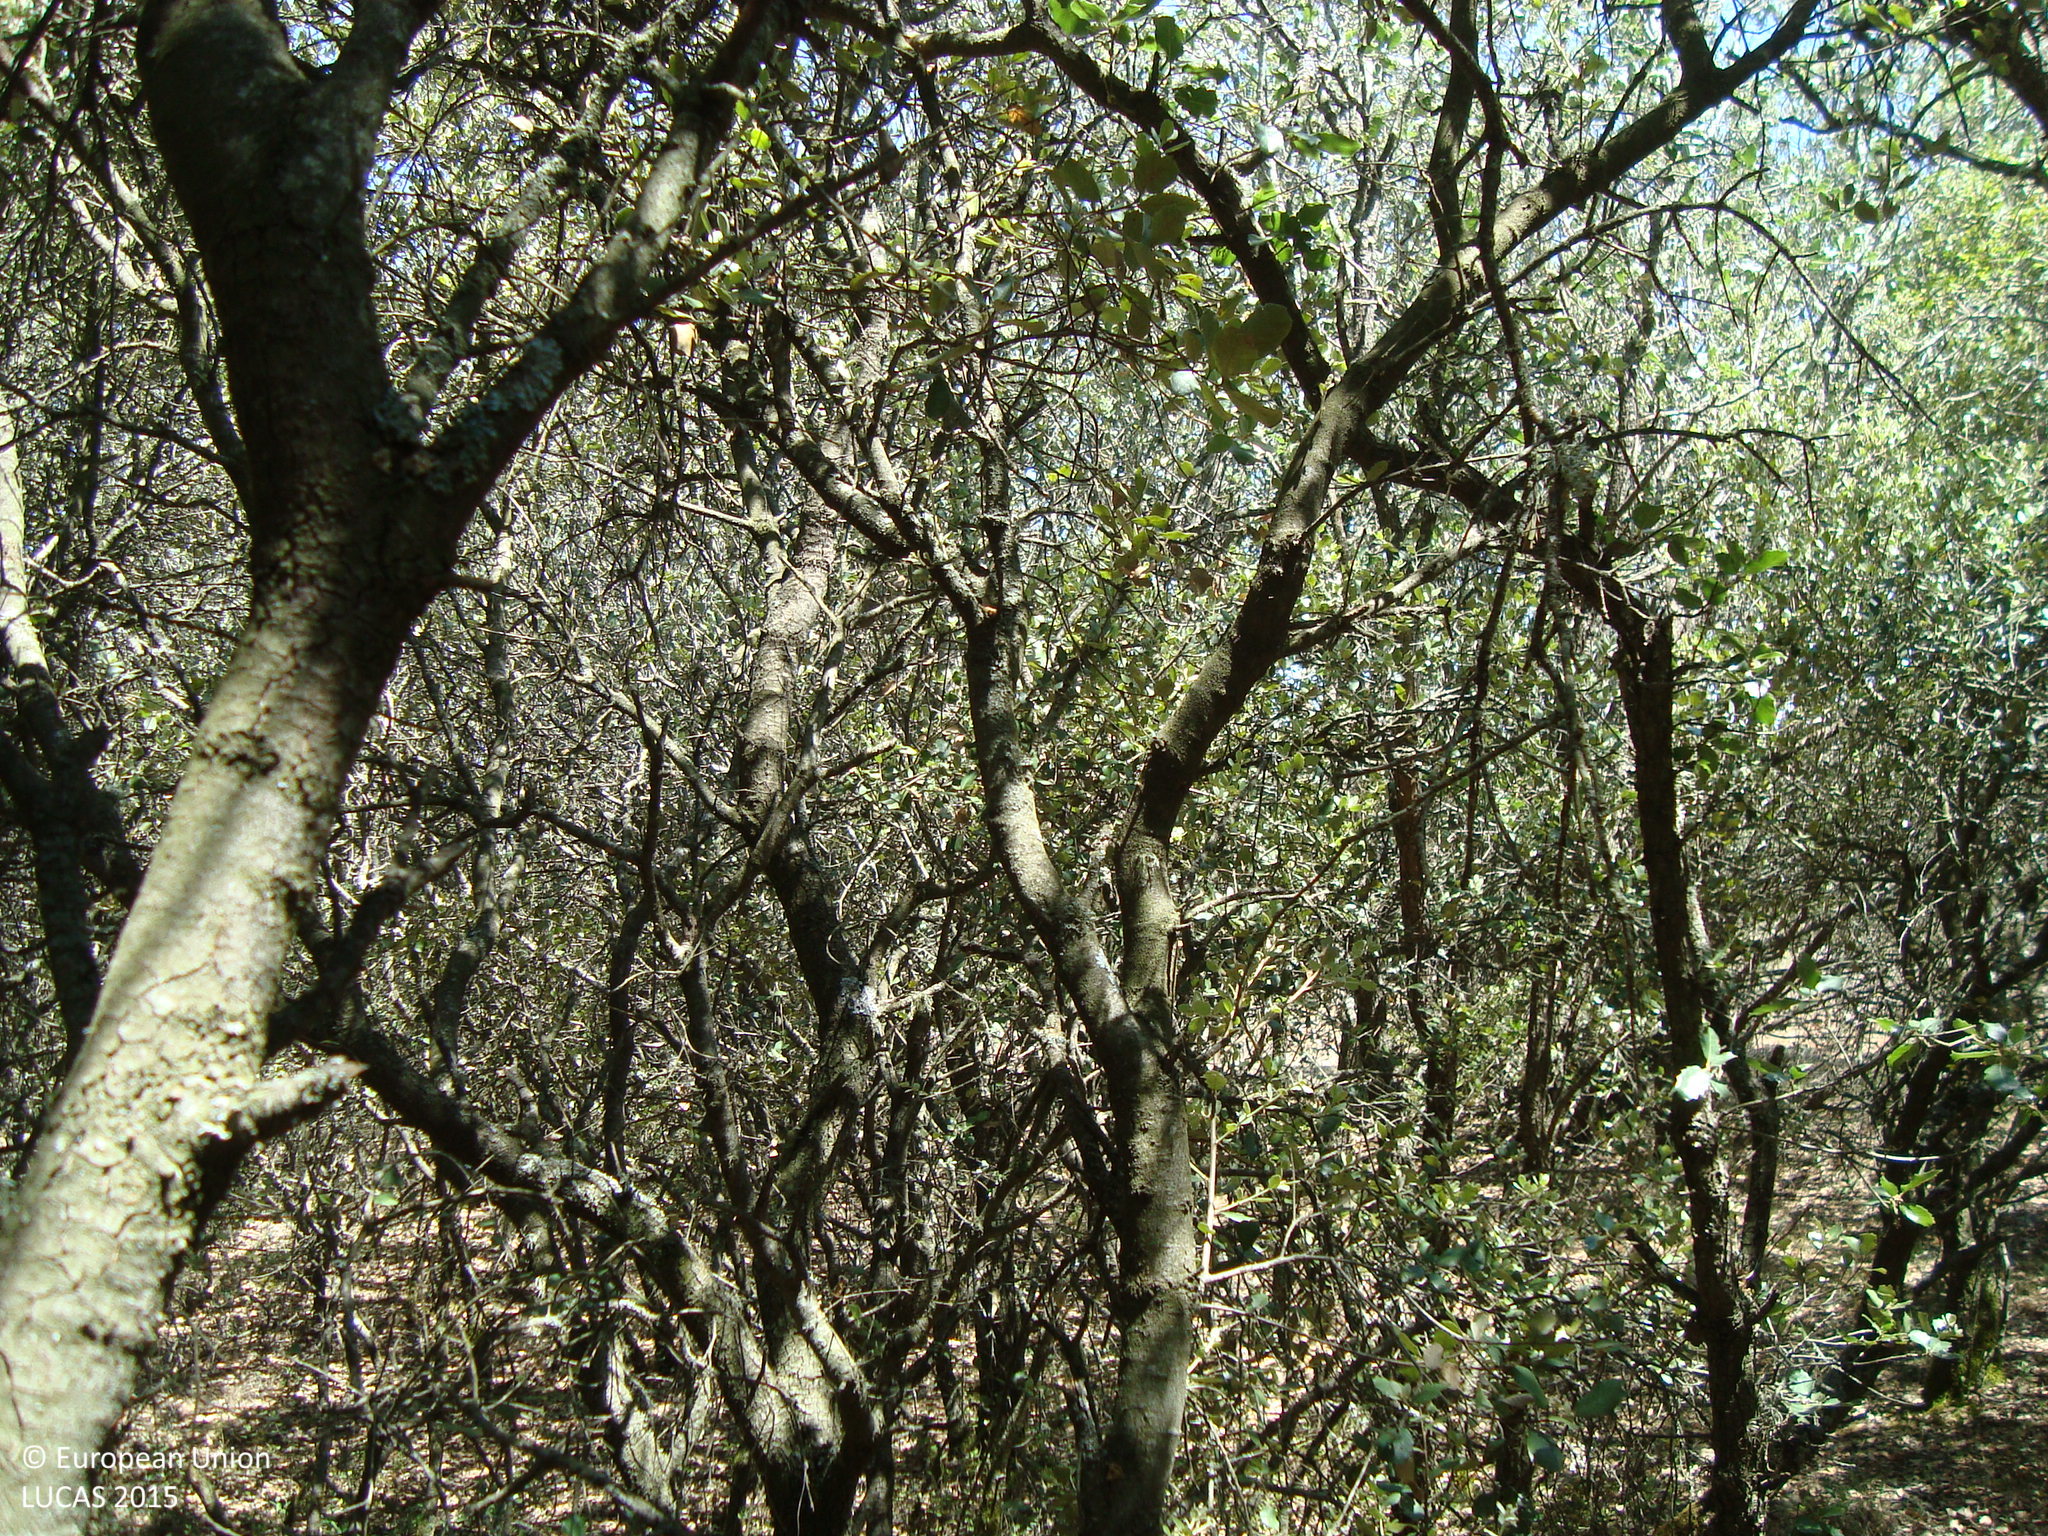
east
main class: Woodland
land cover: Broadleaved woodland
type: broadleaved evergreen forest
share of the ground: > 75 %
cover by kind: broadleaved forest trees 85 %, shrubs 10 %, unconsolidated bare surface 5 %
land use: Forestry
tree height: > 5 m
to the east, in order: Broadleaved woodland; Shrubland without tree cover
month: July
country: ES
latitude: 42.0739
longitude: -4.2931
